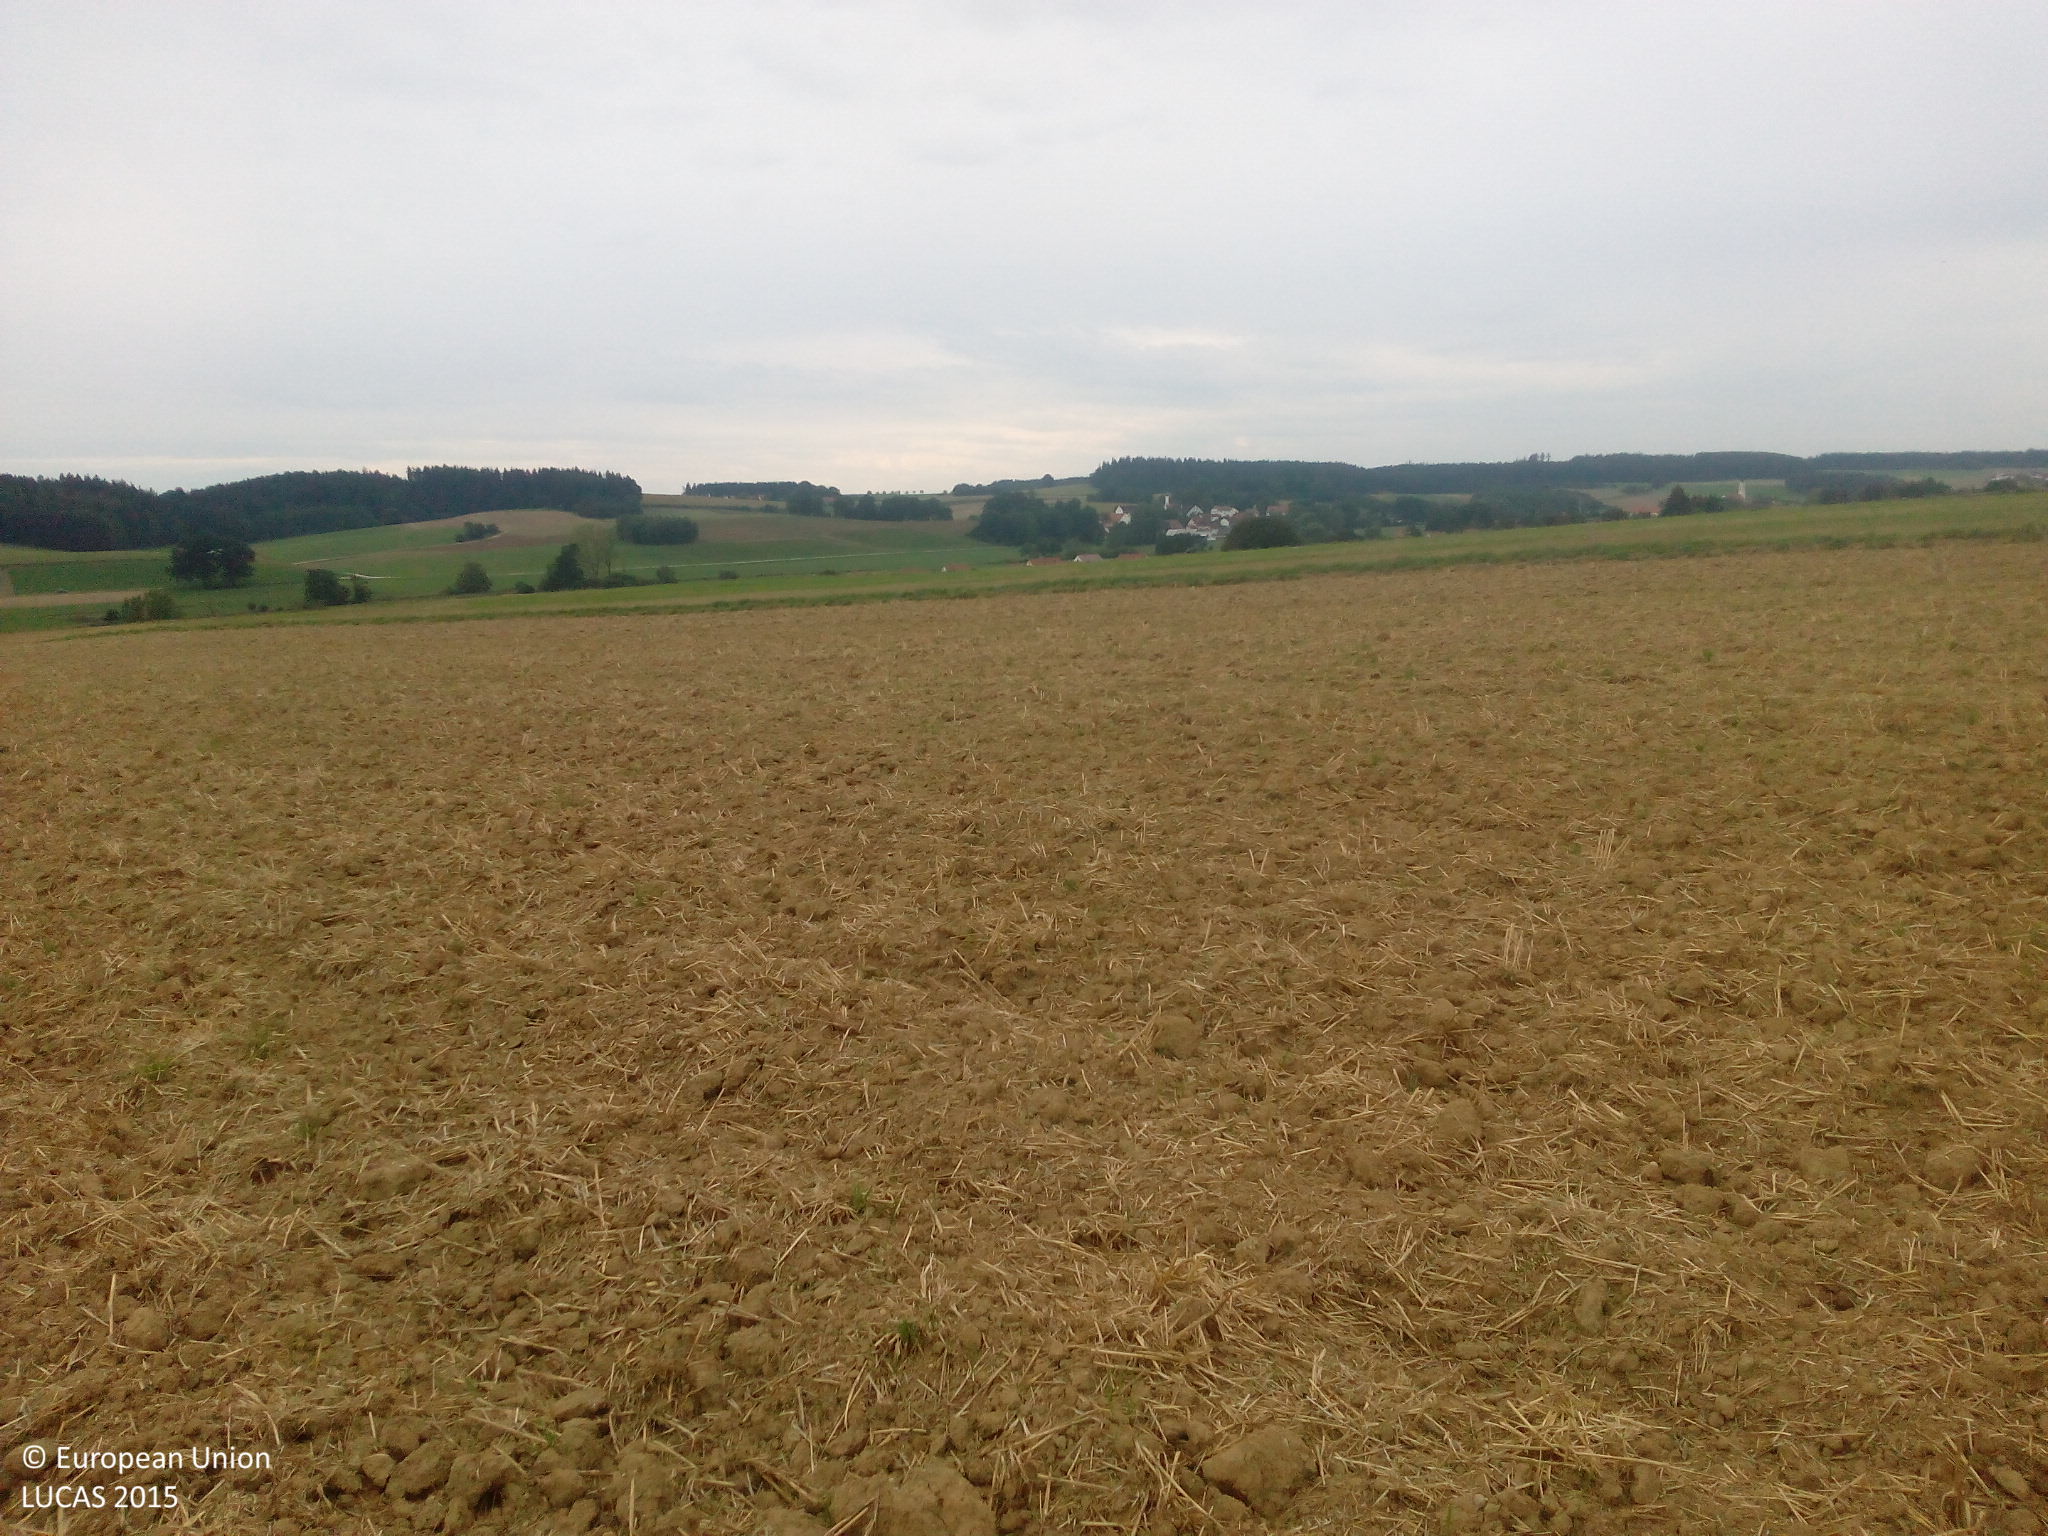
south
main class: Cropland
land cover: Common wheat
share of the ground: < 10 %
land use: Agriculture (excluding fallow land and kitchen gardens)
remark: Harvested field
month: September
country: DE
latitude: 48.4477
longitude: 11.4729
